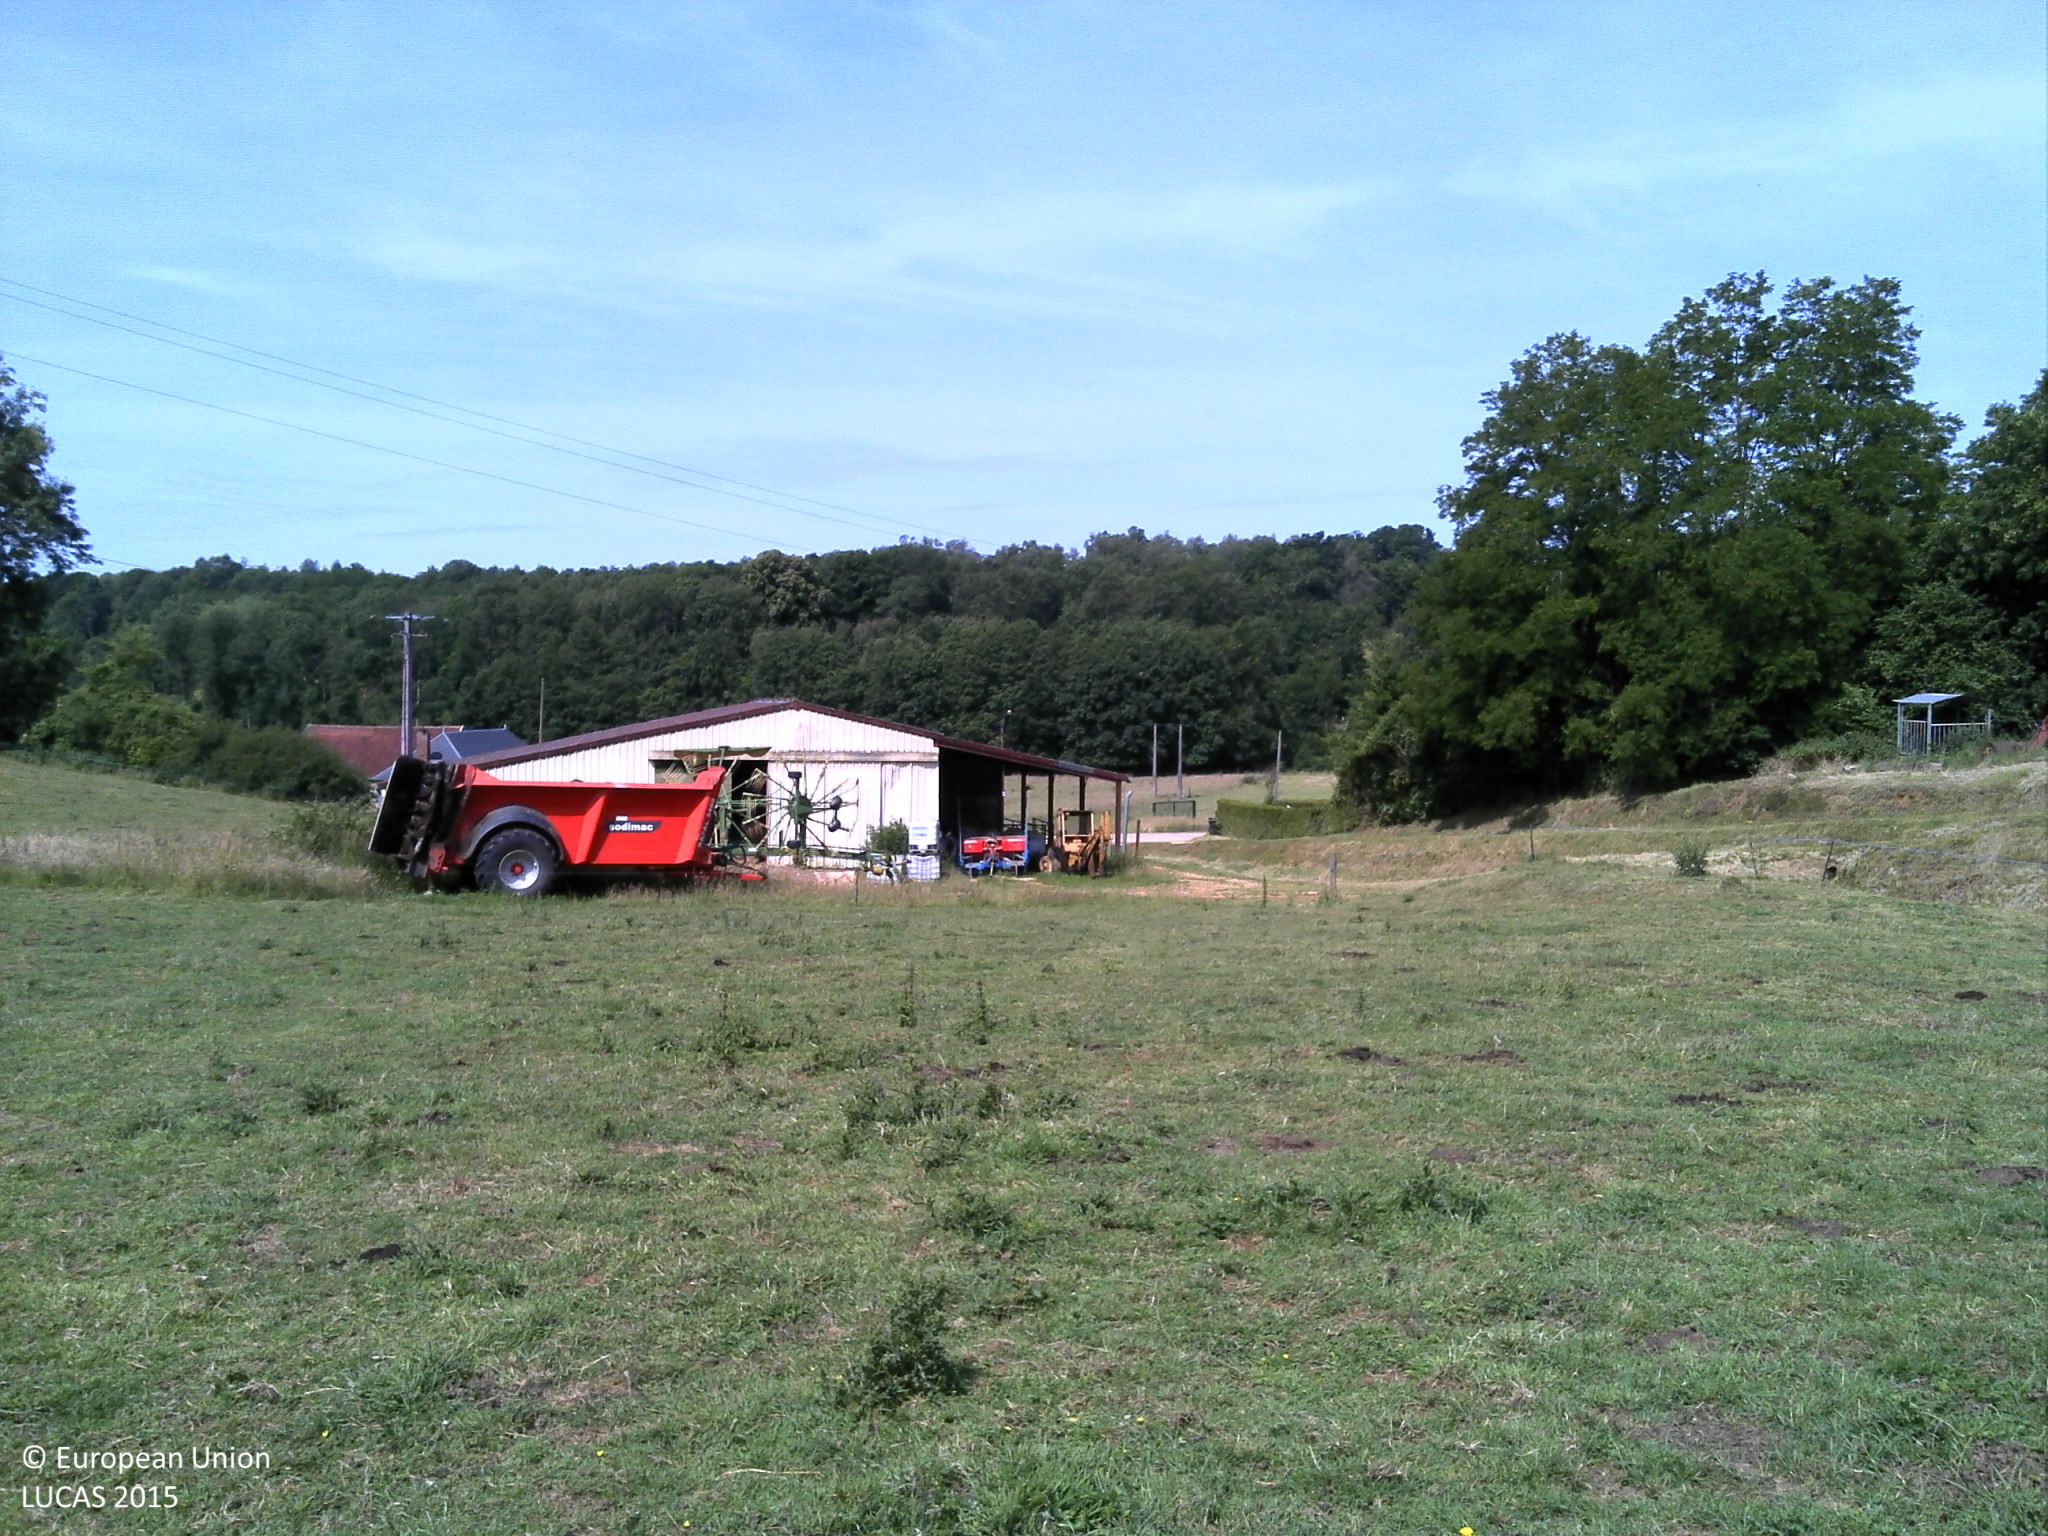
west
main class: Grassland
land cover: Grassland without tree/shrub cover
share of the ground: > 75 %
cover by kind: herbaceous plants 100 %
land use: Agriculture (excluding fallow land and kitchen gardens)
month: June
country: FR
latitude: 49.6959
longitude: 4.9927
